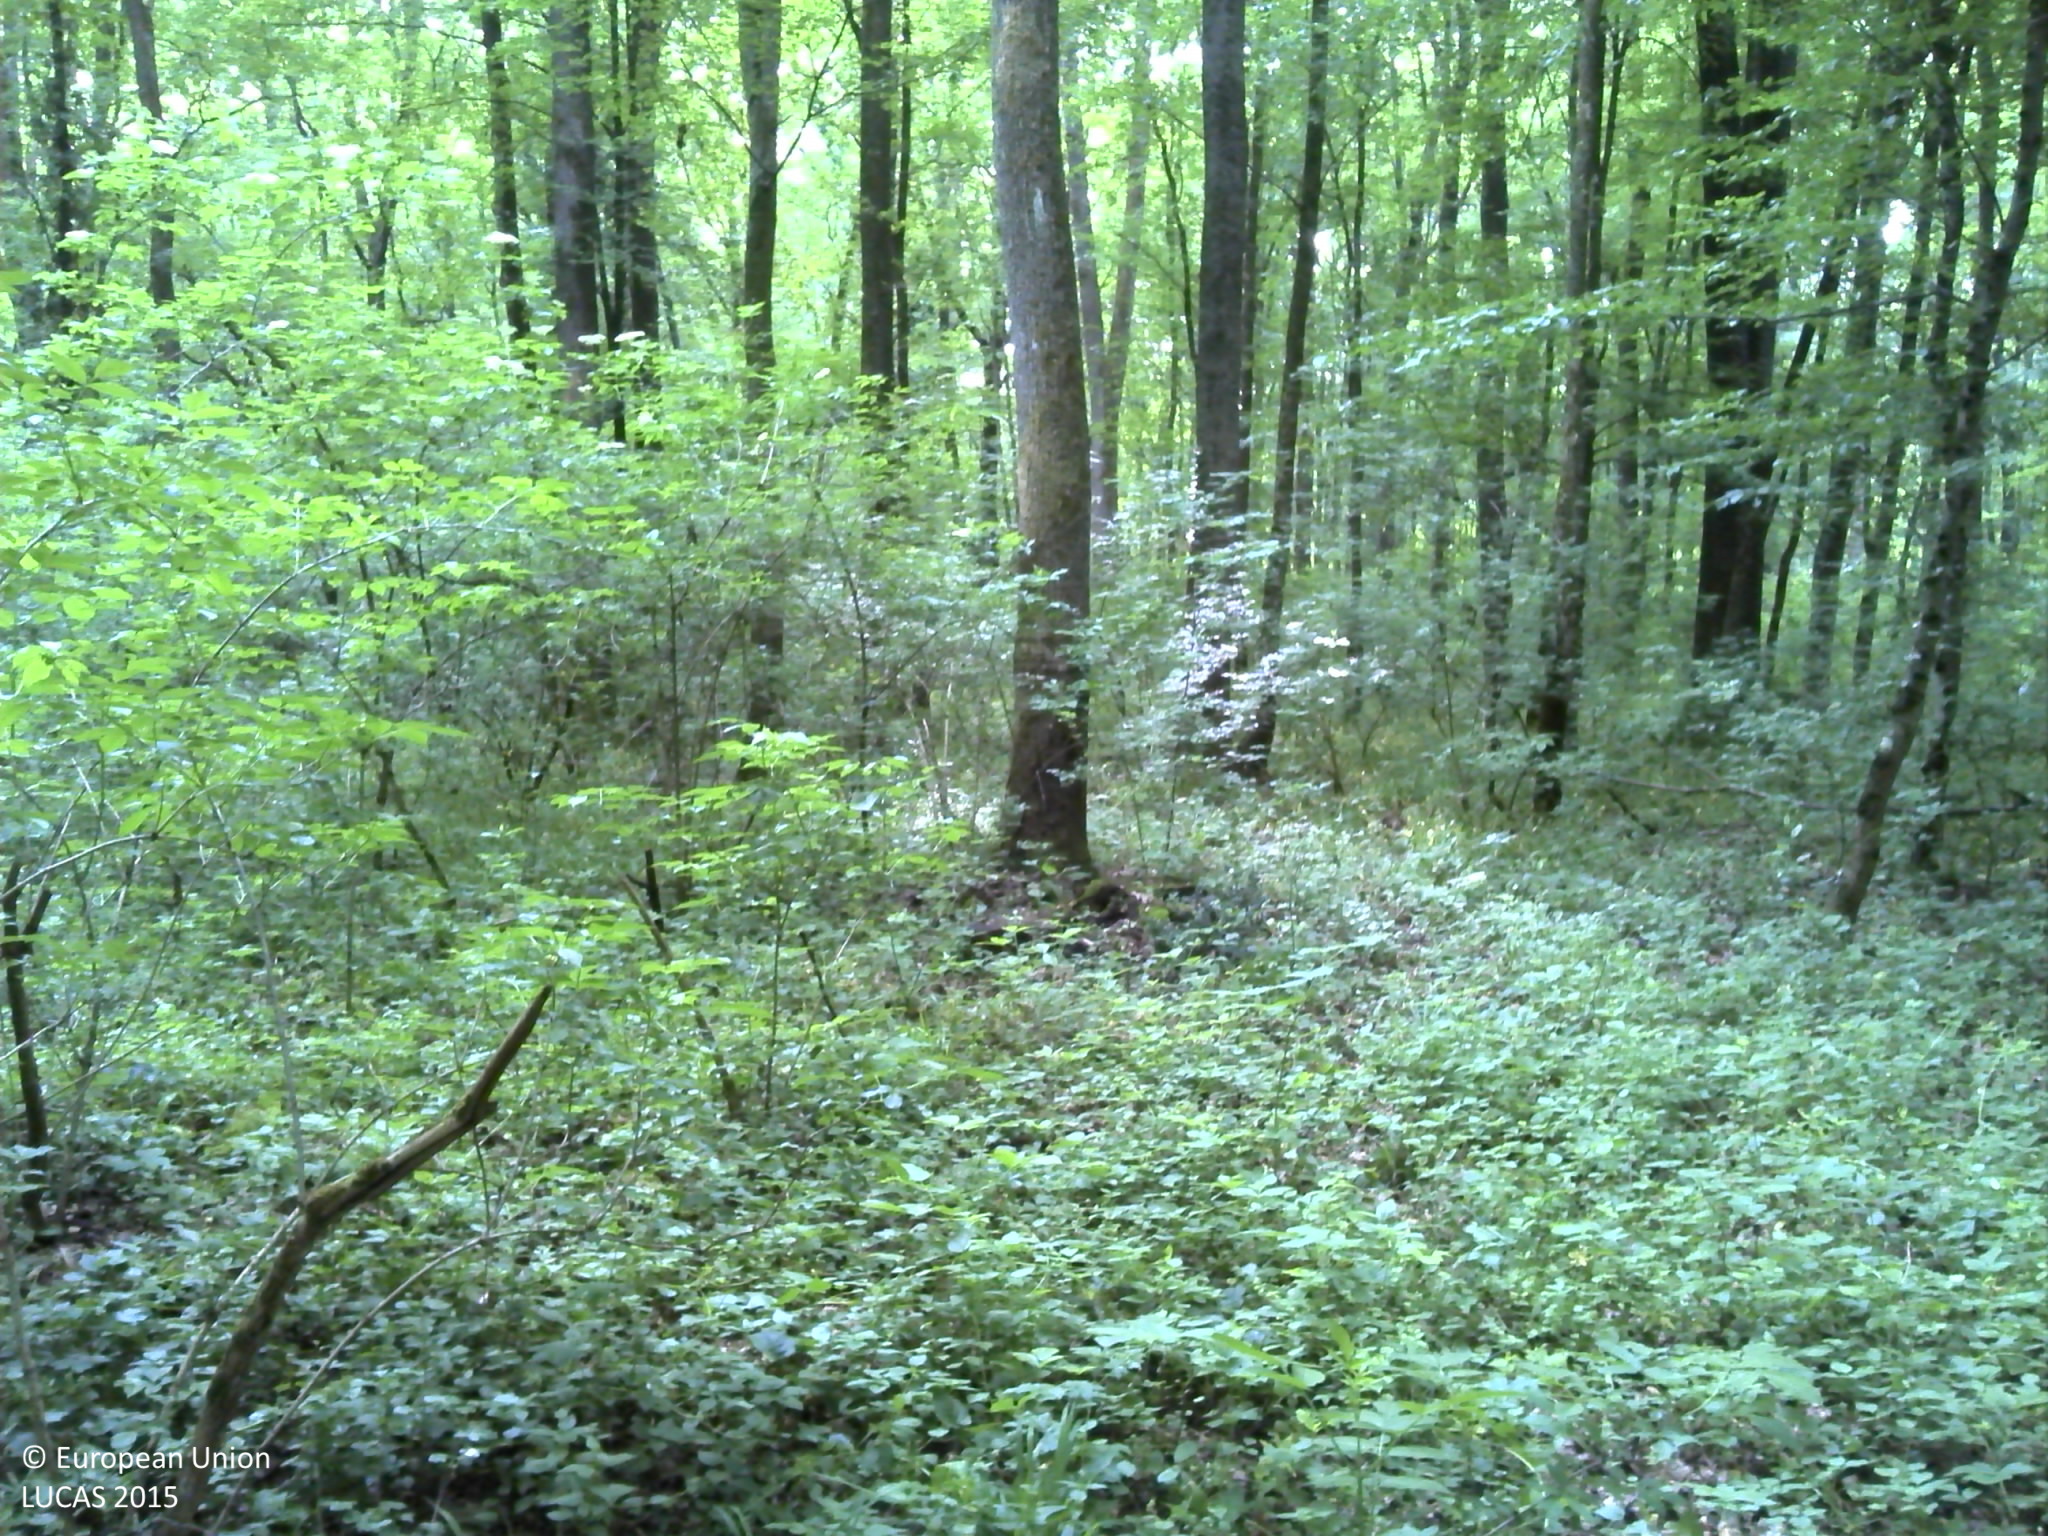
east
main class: Woodland
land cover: Broadleaved woodland
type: acidophilous oak and oak-birch forest
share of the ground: > 75 %
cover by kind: broadleaved forest trees 100 %
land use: Forestry
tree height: > 5 m
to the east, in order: Broadleaved woodland; Ditches and canals; Broadleaved woodland
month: May
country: HR
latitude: 45.5818
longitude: 18.2204
